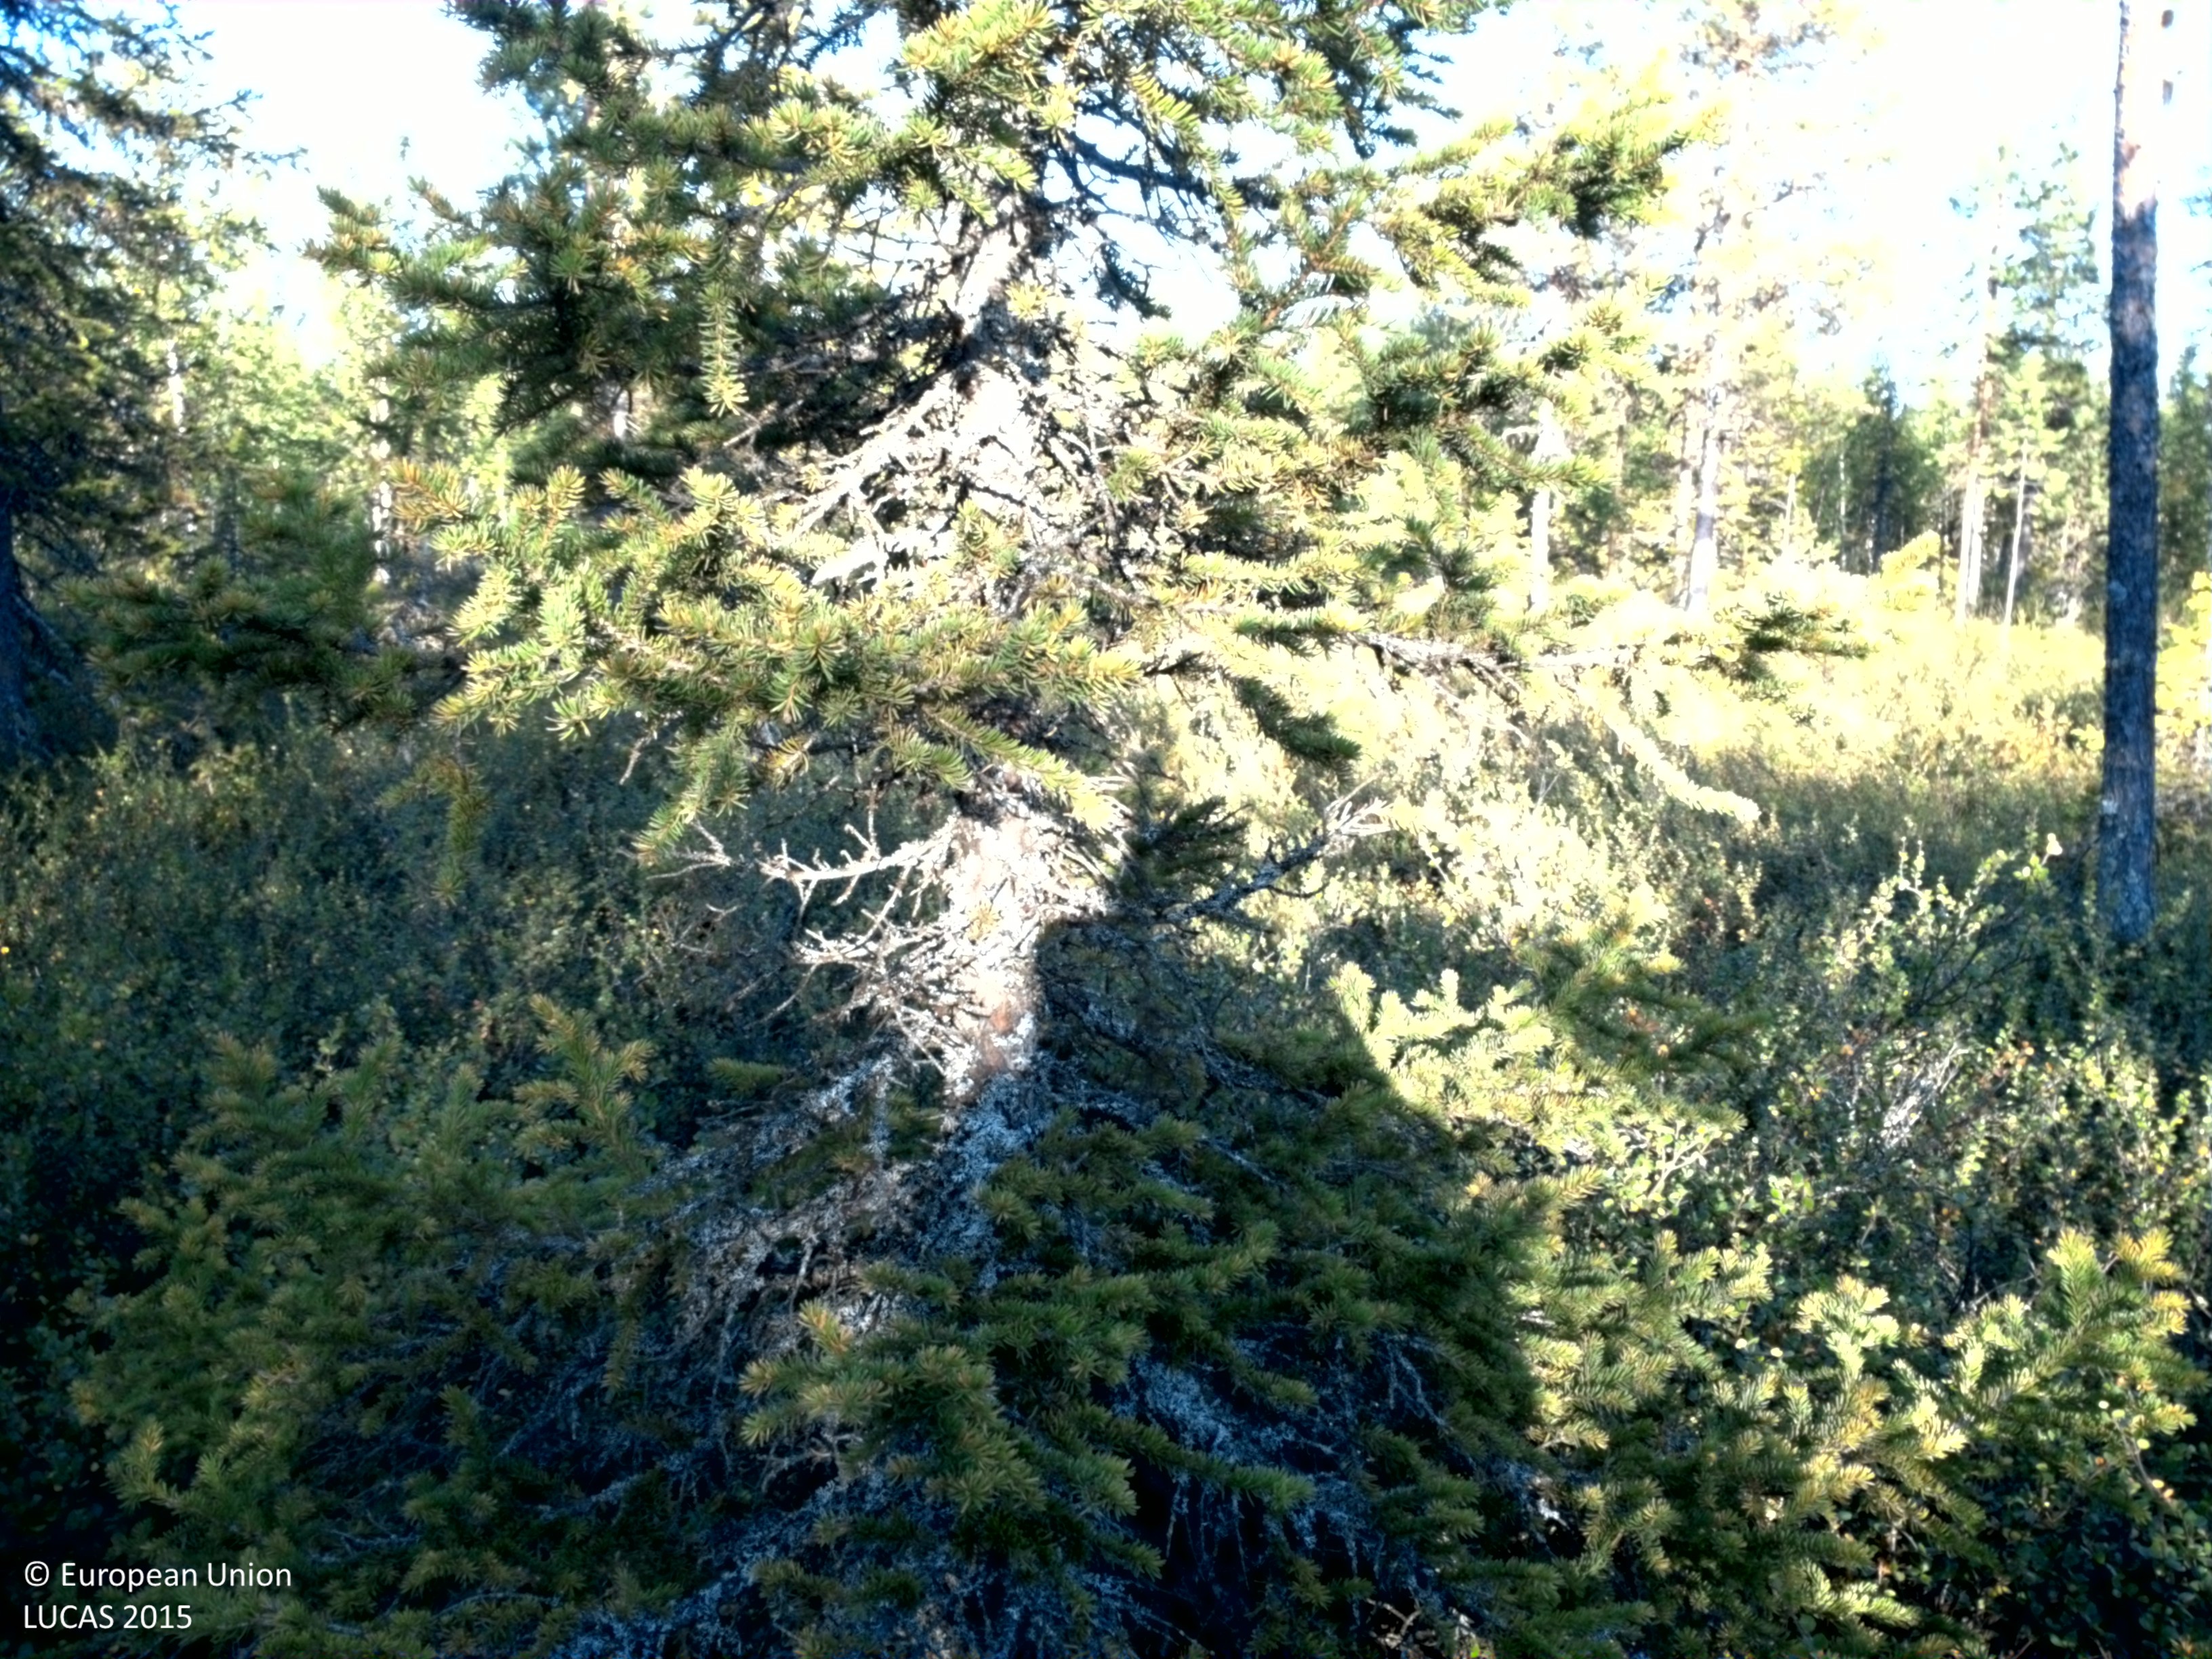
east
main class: Woodland
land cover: Spruce dominated coniferous woodland
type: boreal forest
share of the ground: 10 - 25 %
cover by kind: shrubs 85 %, coniferous forest trees 15 %
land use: Forestry
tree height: > 5 m
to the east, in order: Spruce dominated coniferous woodland; Shrubland with sparse tree cover; Pine dominated mixed woodland; Pine dominated coniferous woodland
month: August
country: SE
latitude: 66.7937
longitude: 19.1593
